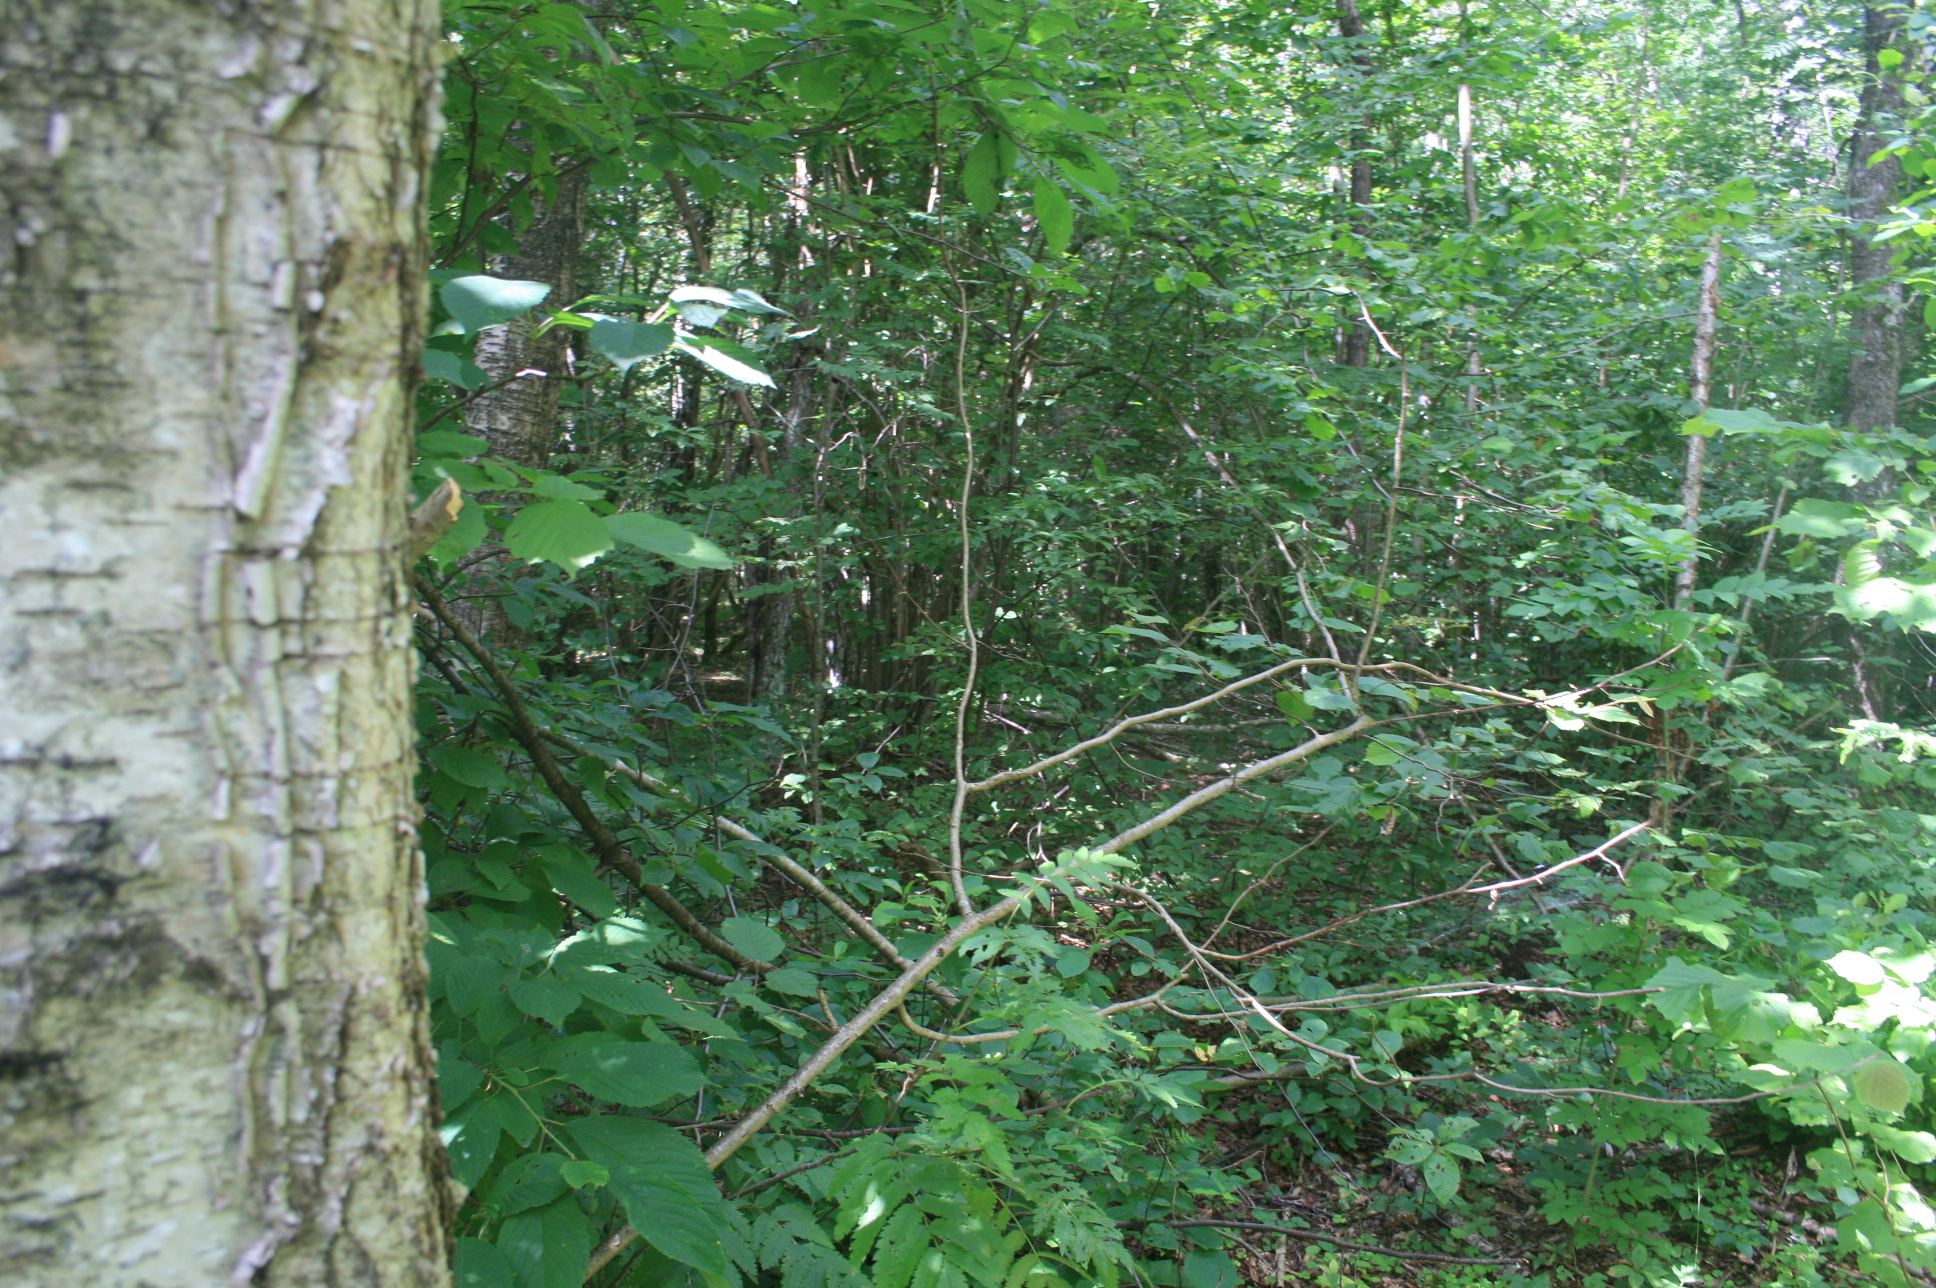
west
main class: Woodland
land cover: Broadleaved woodland
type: non-riverine alder, birch or aspen forest
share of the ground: > 75 %
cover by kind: broadleaved forest trees 90 %, shrubs 5 %, herbaceous plants 5 %
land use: Forestry
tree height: > 5 m
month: July
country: LT
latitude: 55.7857
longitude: 21.4135
